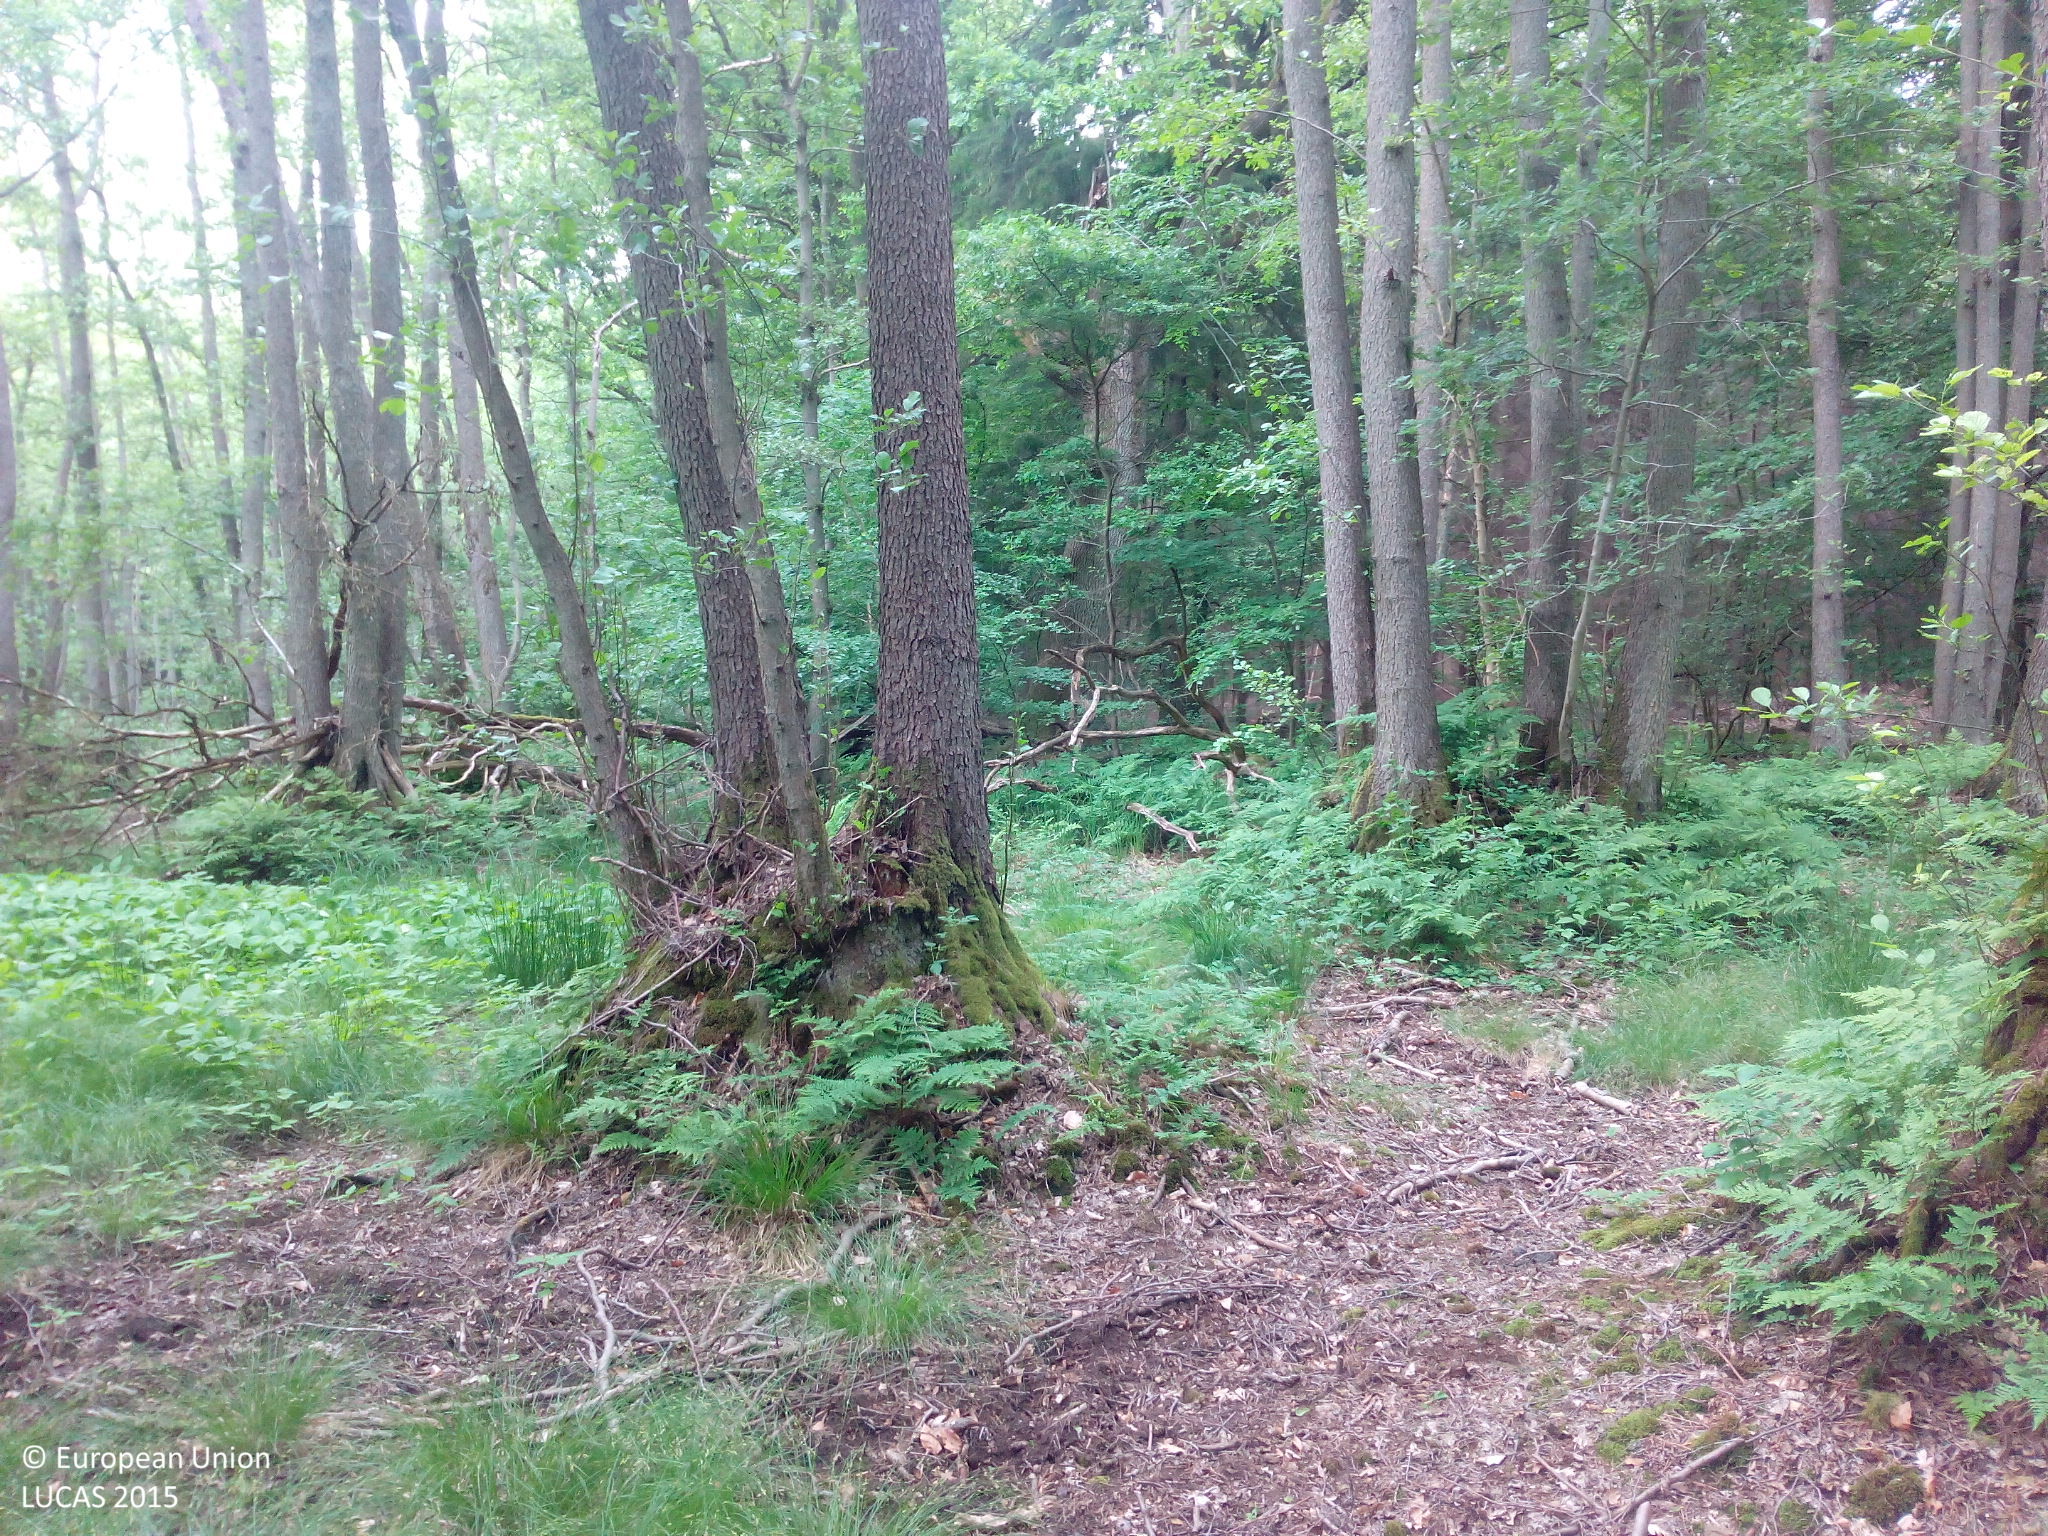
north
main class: Woodland
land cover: Broadleaved woodland
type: mesophytic deciduous forest
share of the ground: 50 - 75 %
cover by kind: broadleaved forest trees 60 %, herbaceous plants 20 %, unconsolidated bare surface 20 %
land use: Forestry
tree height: > 5 m
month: June
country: DE
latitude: 53.6604
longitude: 11.6487
